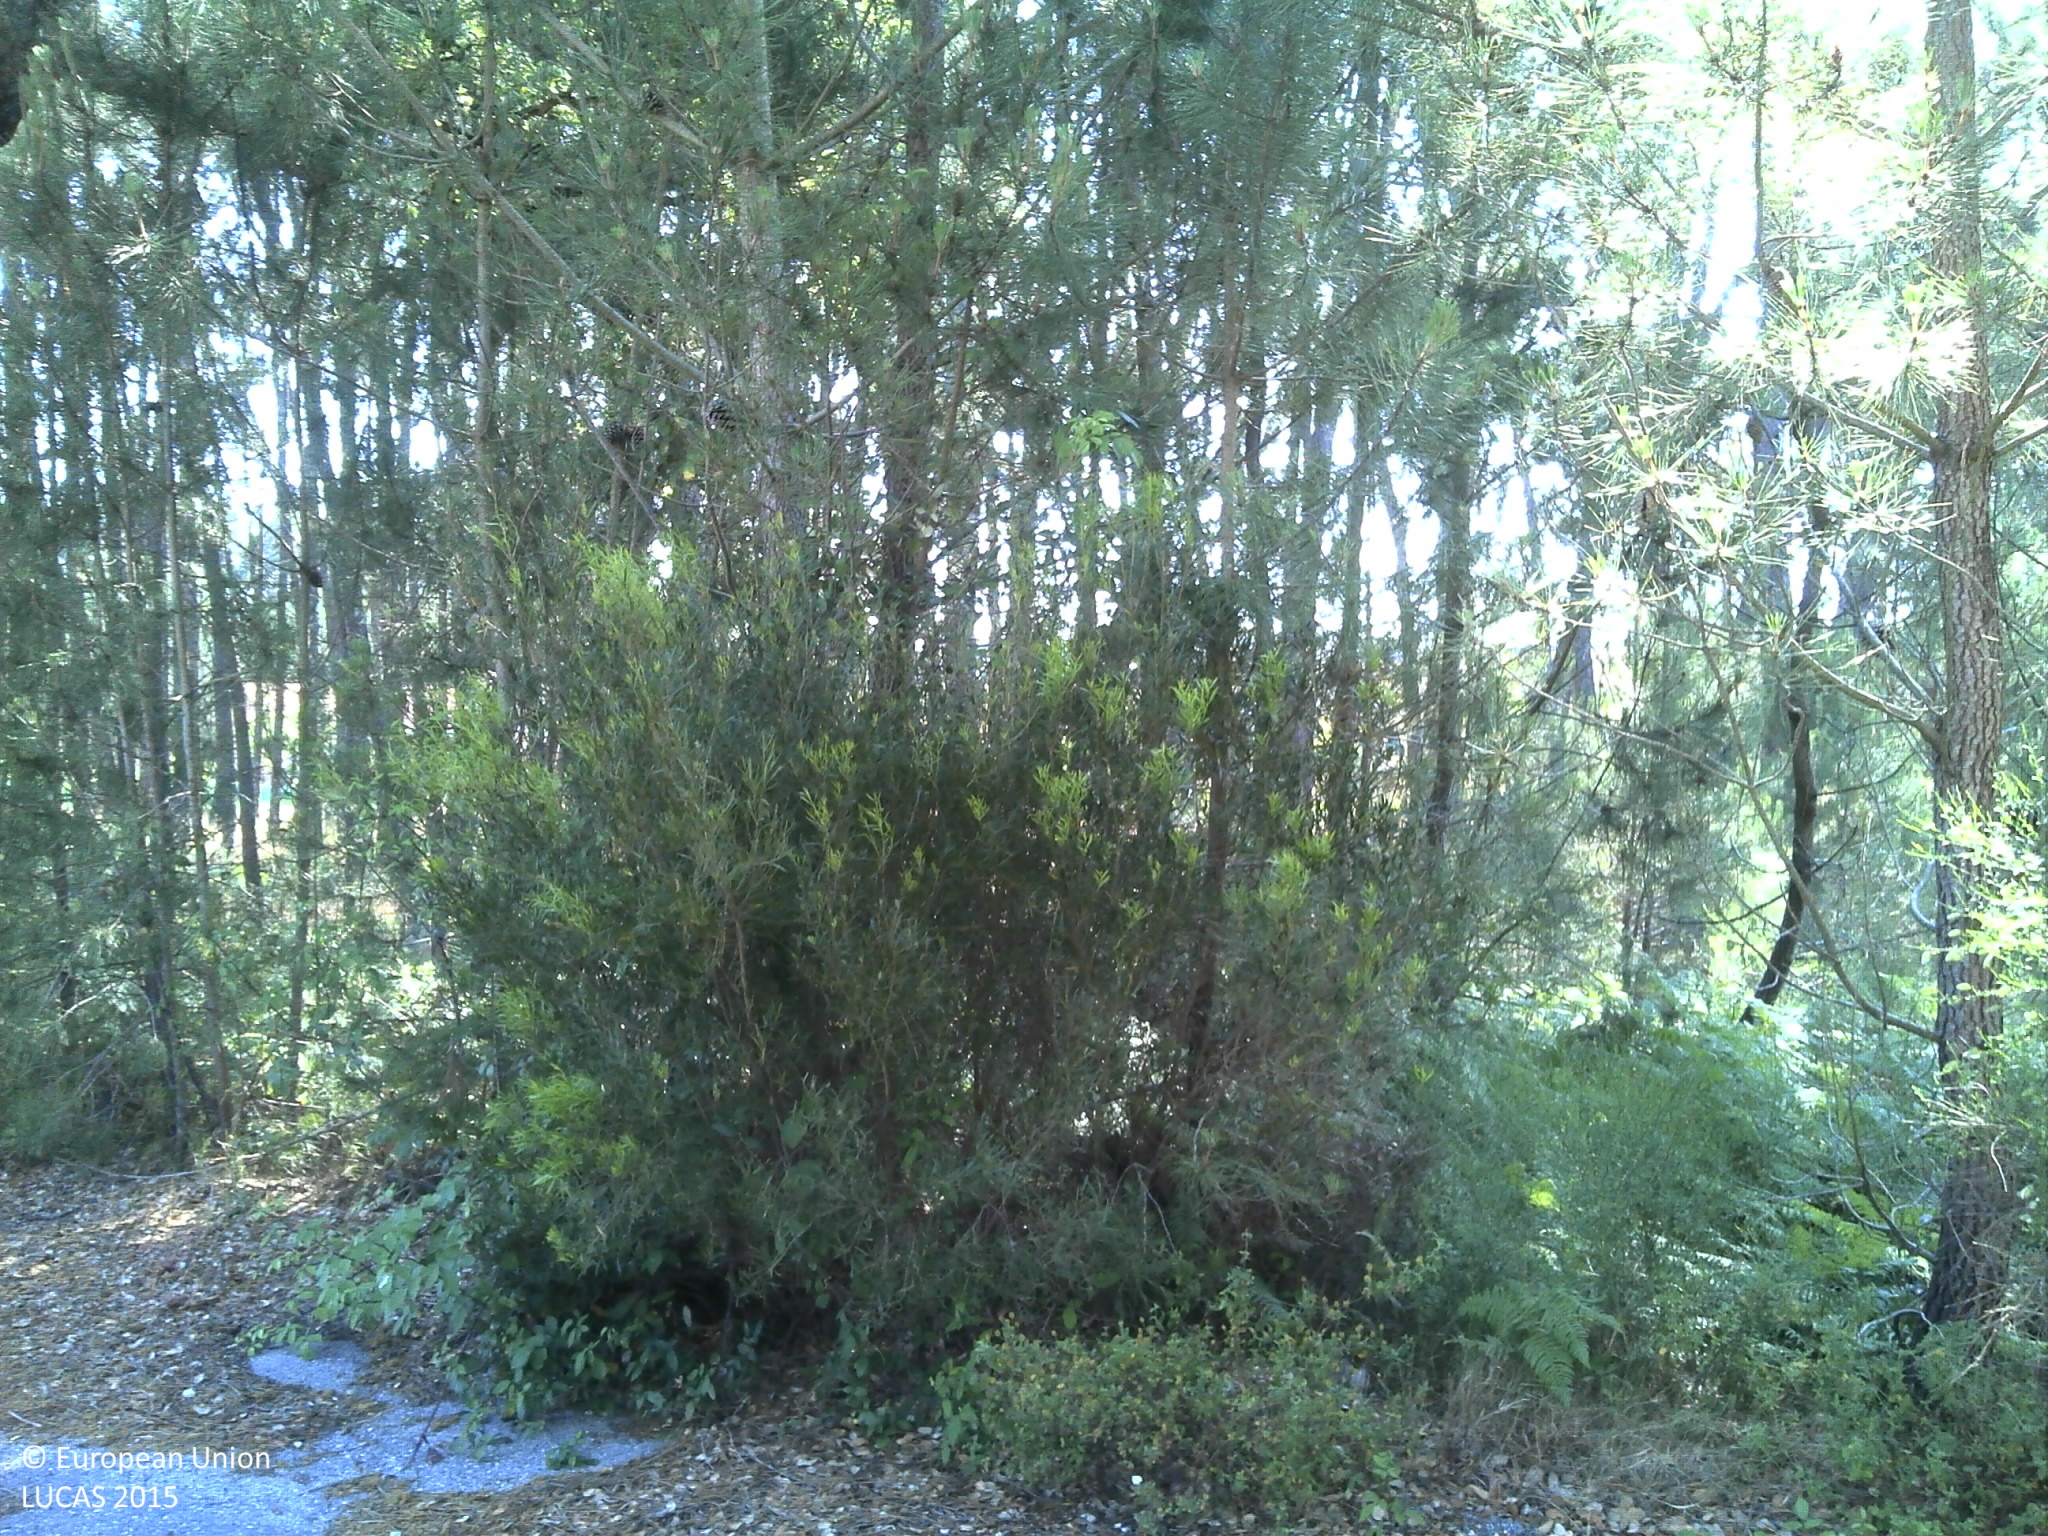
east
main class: Woodland
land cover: Pine dominated coniferous woodland
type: coniferous forest of the mediterranean region
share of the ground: 50 - 75 %
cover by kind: coniferous forest trees 60 %, unconsolidated bare surface 35 %, herbaceous plants 5 %
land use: Forestry
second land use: Agriculture (excluding fallow land and kitchen gardens)
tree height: > 5 m
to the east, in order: Pine dominated coniferous woodland; Fences; Spontaneously vegetated surfaces; Fences; Paved roads, cycling and walking lanes; Pine dominated coniferous woodland; Other root crops; Spontaneously vegetated surfaces; Tracks; Grassland without tree/shrub cover; Fences; Grassland with sparse tree/shrub cover; Paved roads, cycling and walking lanes; Grassland without tree/shrub cover
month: June
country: PT
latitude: 40.3556
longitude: -8.7098
